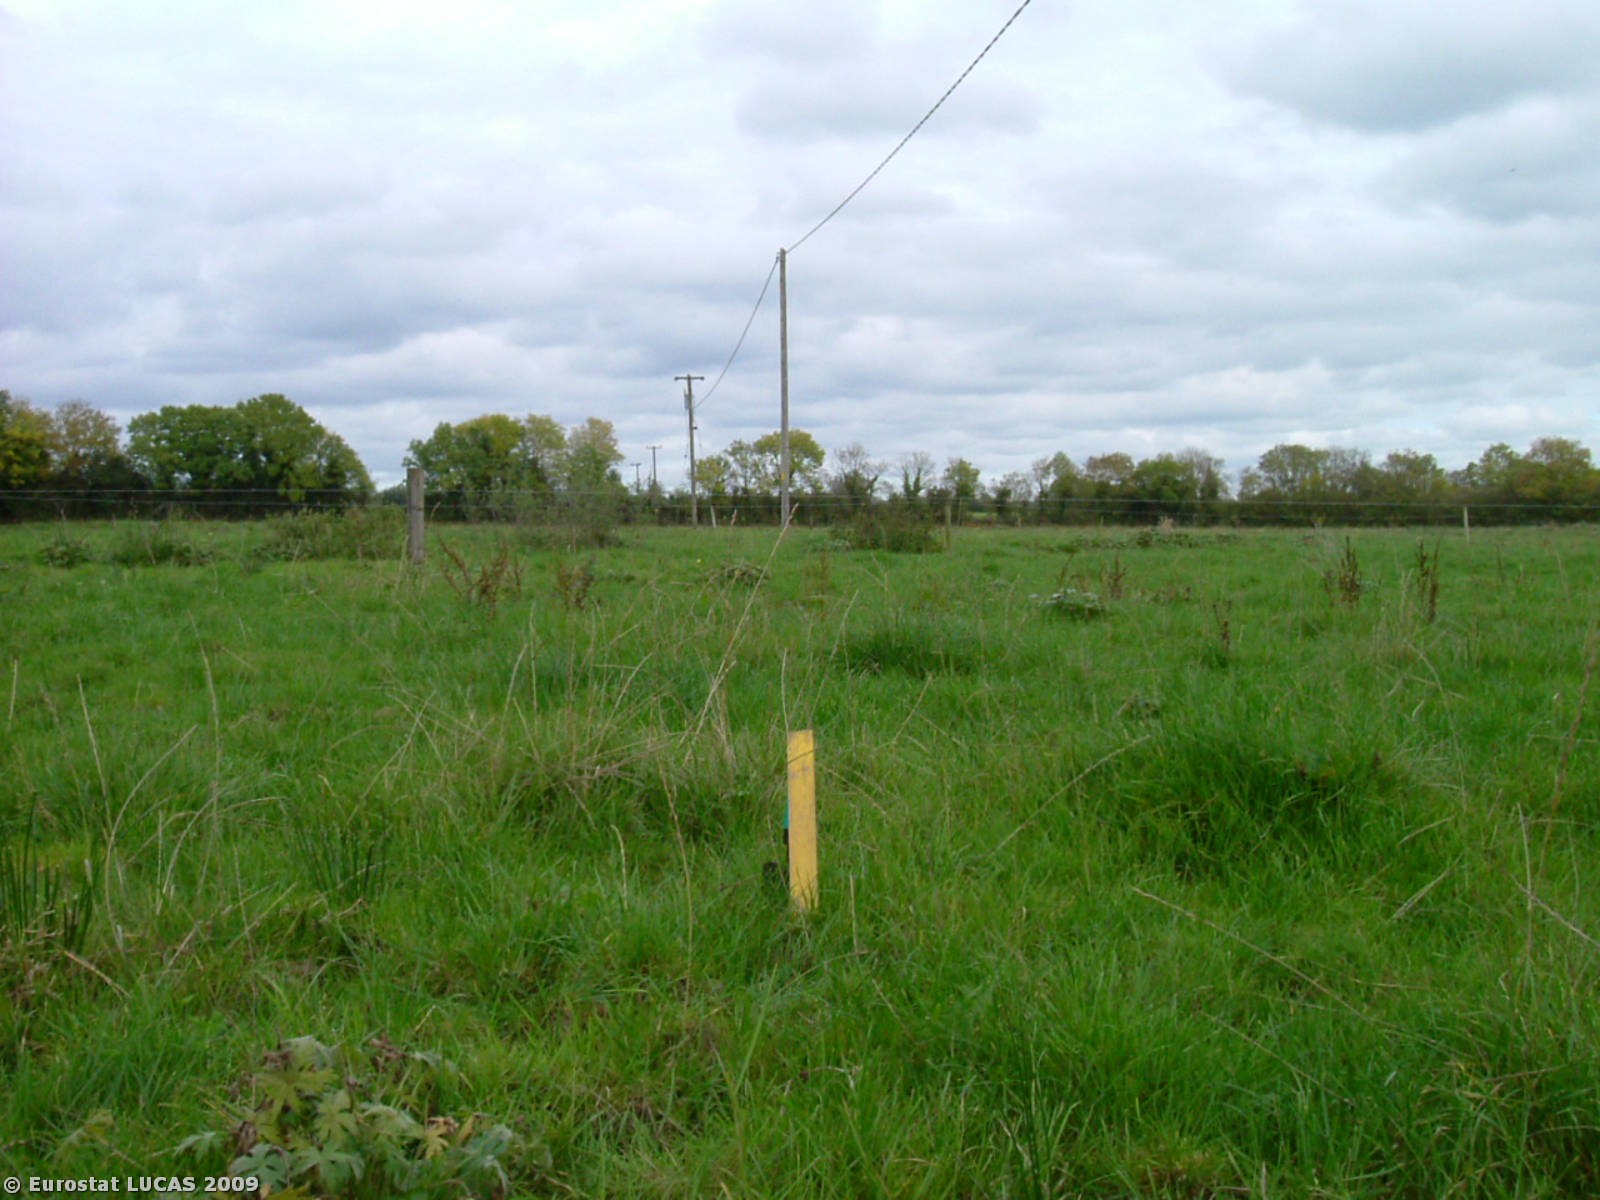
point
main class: Grassland
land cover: Grassland without tree/shrub cover
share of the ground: > 75 %
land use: Agriculture (excluding fallow land and kitchen gardens)
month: October
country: IE
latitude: 52.5380
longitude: -8.2149
